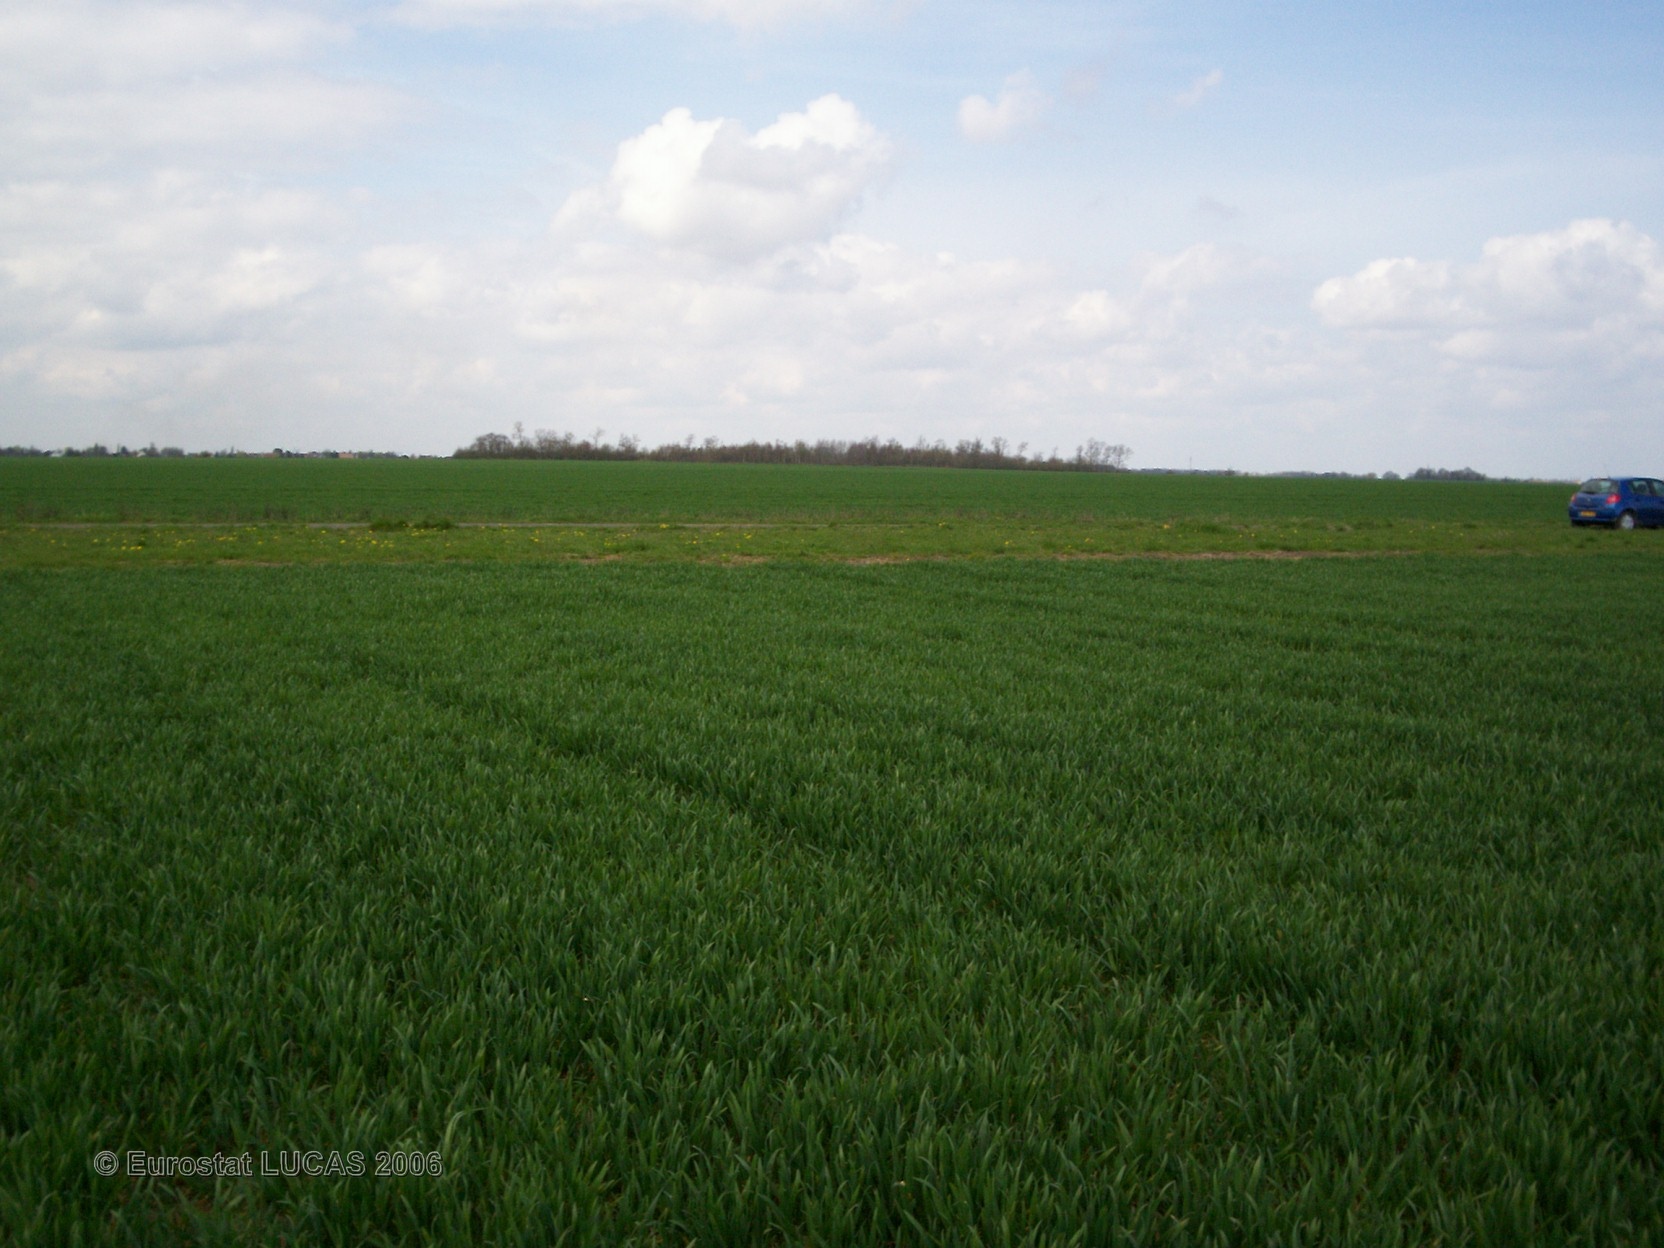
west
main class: Cropland
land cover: Common wheat
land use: Agriculture (excluding fallow land and kitchen gardens)
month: April
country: FR
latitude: 49.0530
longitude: 1.0434
